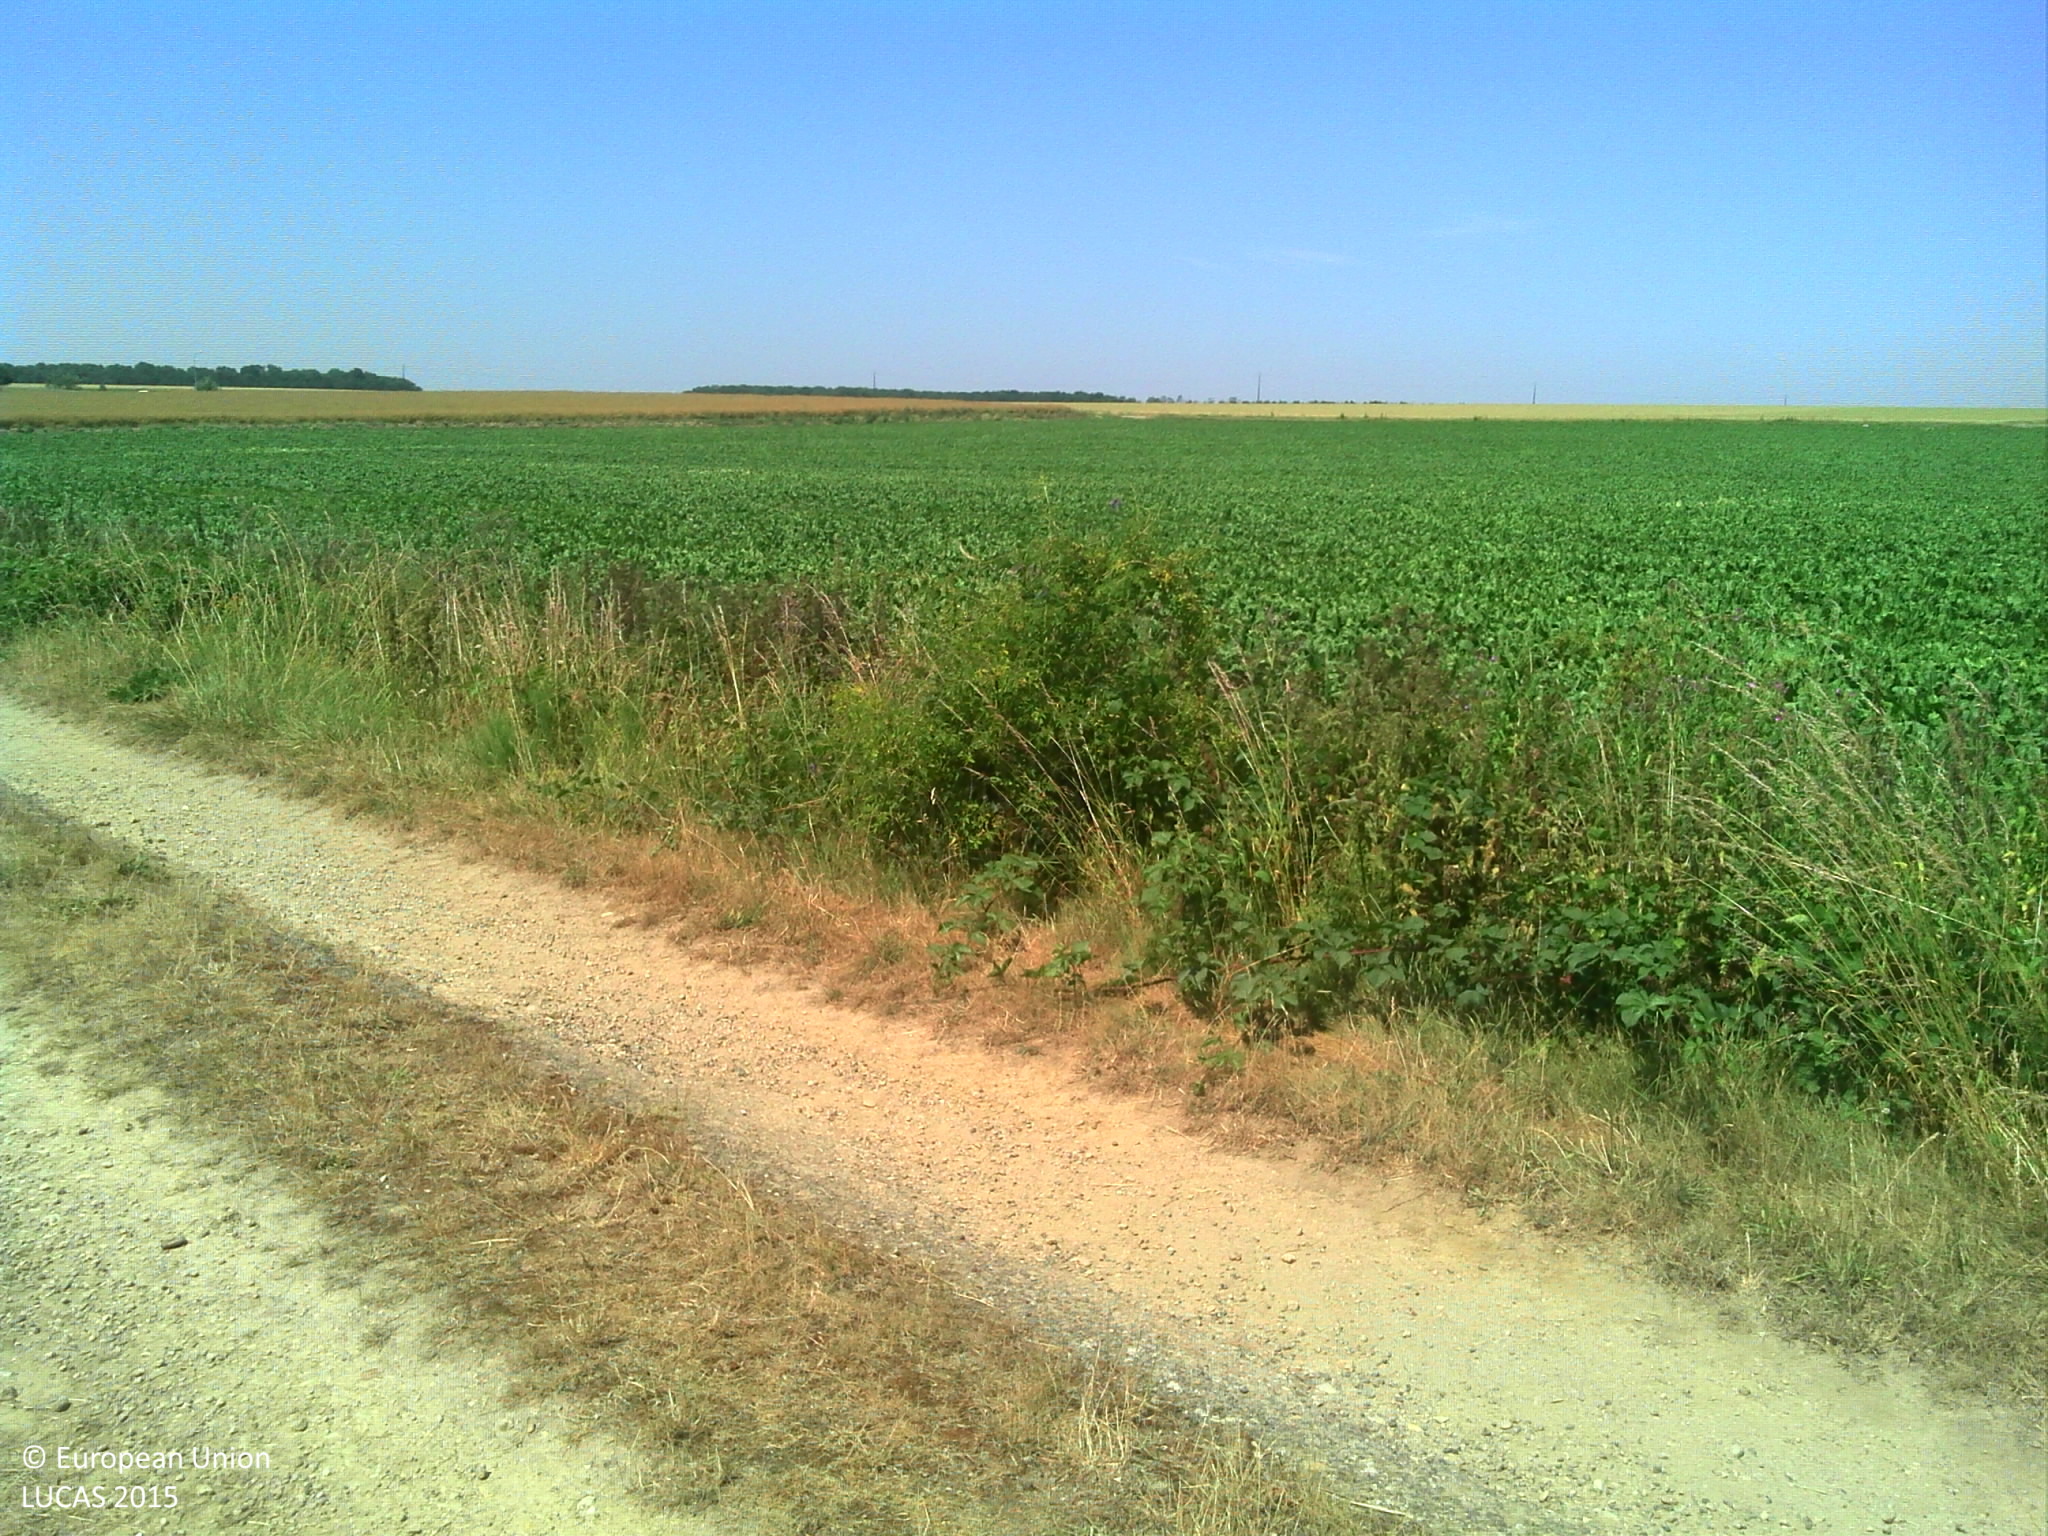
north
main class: Cropland
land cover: Rape and turnip rape
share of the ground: > 75 %
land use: Agriculture (excluding fallow land and kitchen gardens)
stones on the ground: < 10 %
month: July
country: FR
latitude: 49.0699
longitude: 3.3539
